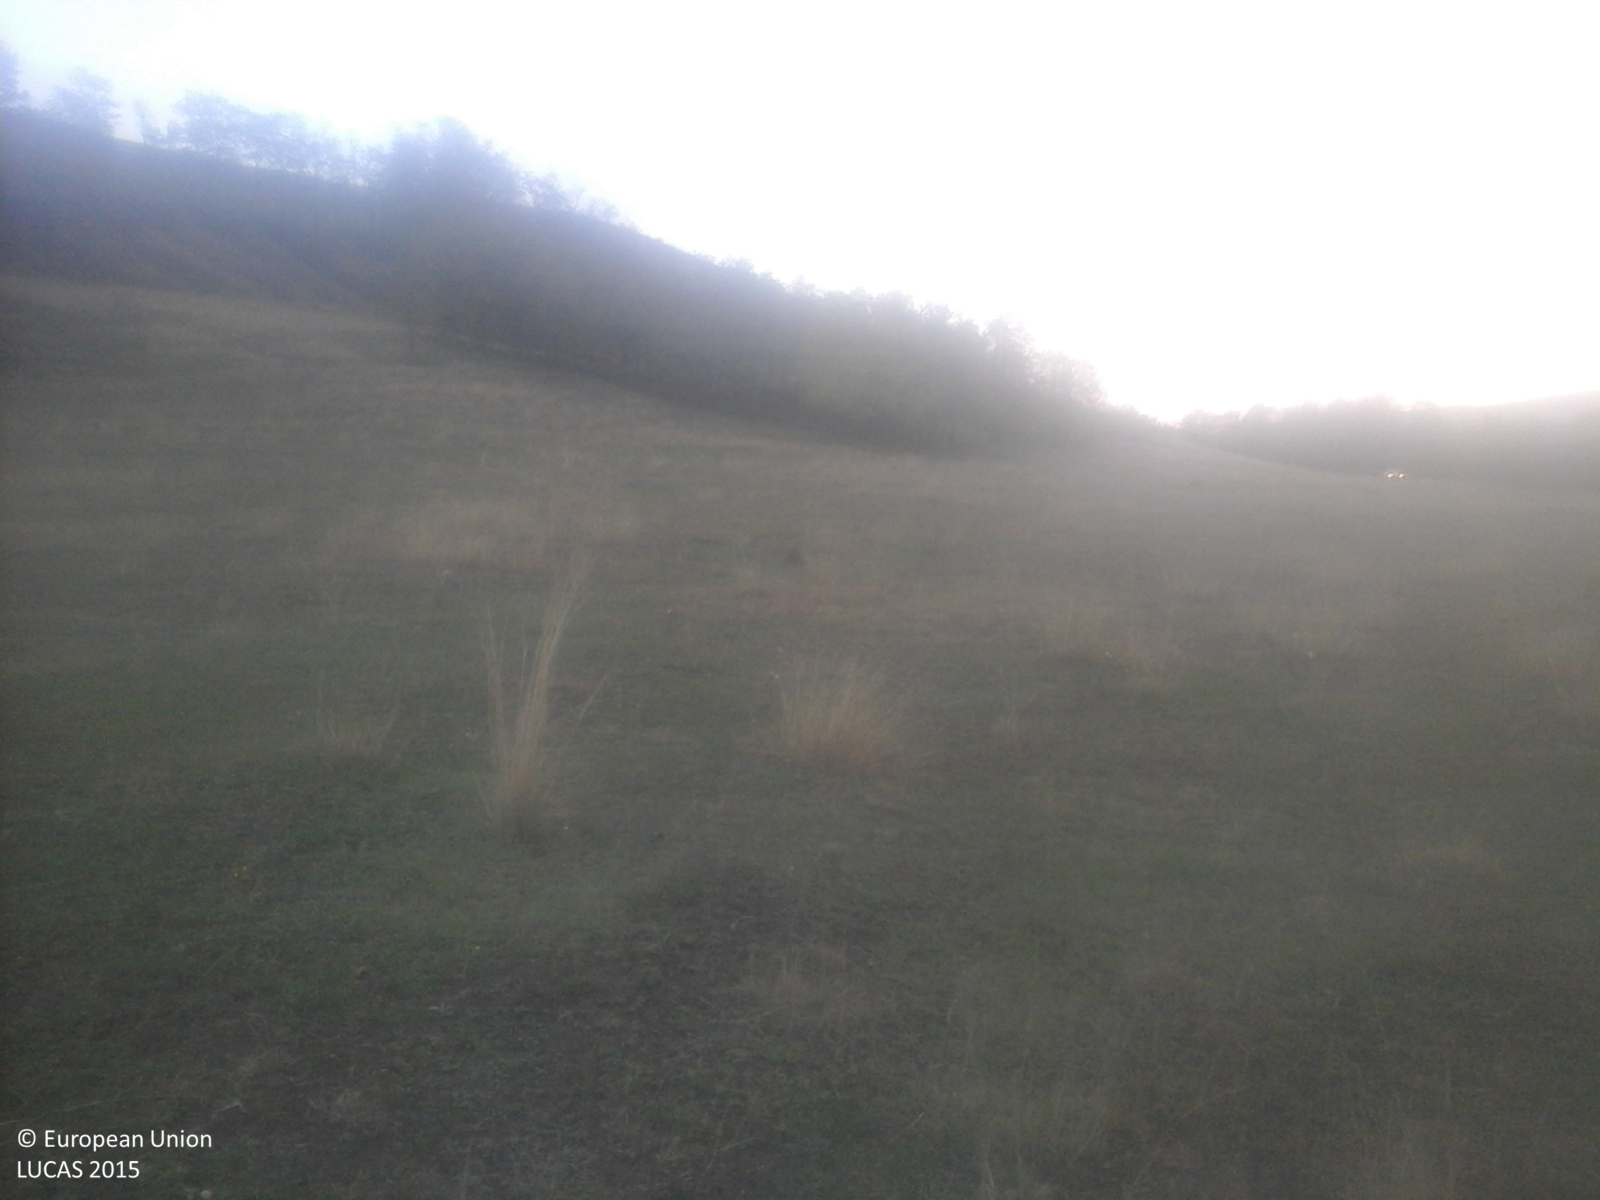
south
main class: Grassland
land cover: Grassland without tree/shrub cover
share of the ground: > 75 %
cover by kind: herbaceous plants 100 %
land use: Agriculture (excluding fallow land and kitchen gardens)
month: October
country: RO
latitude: 45.3661
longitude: 26.8724
